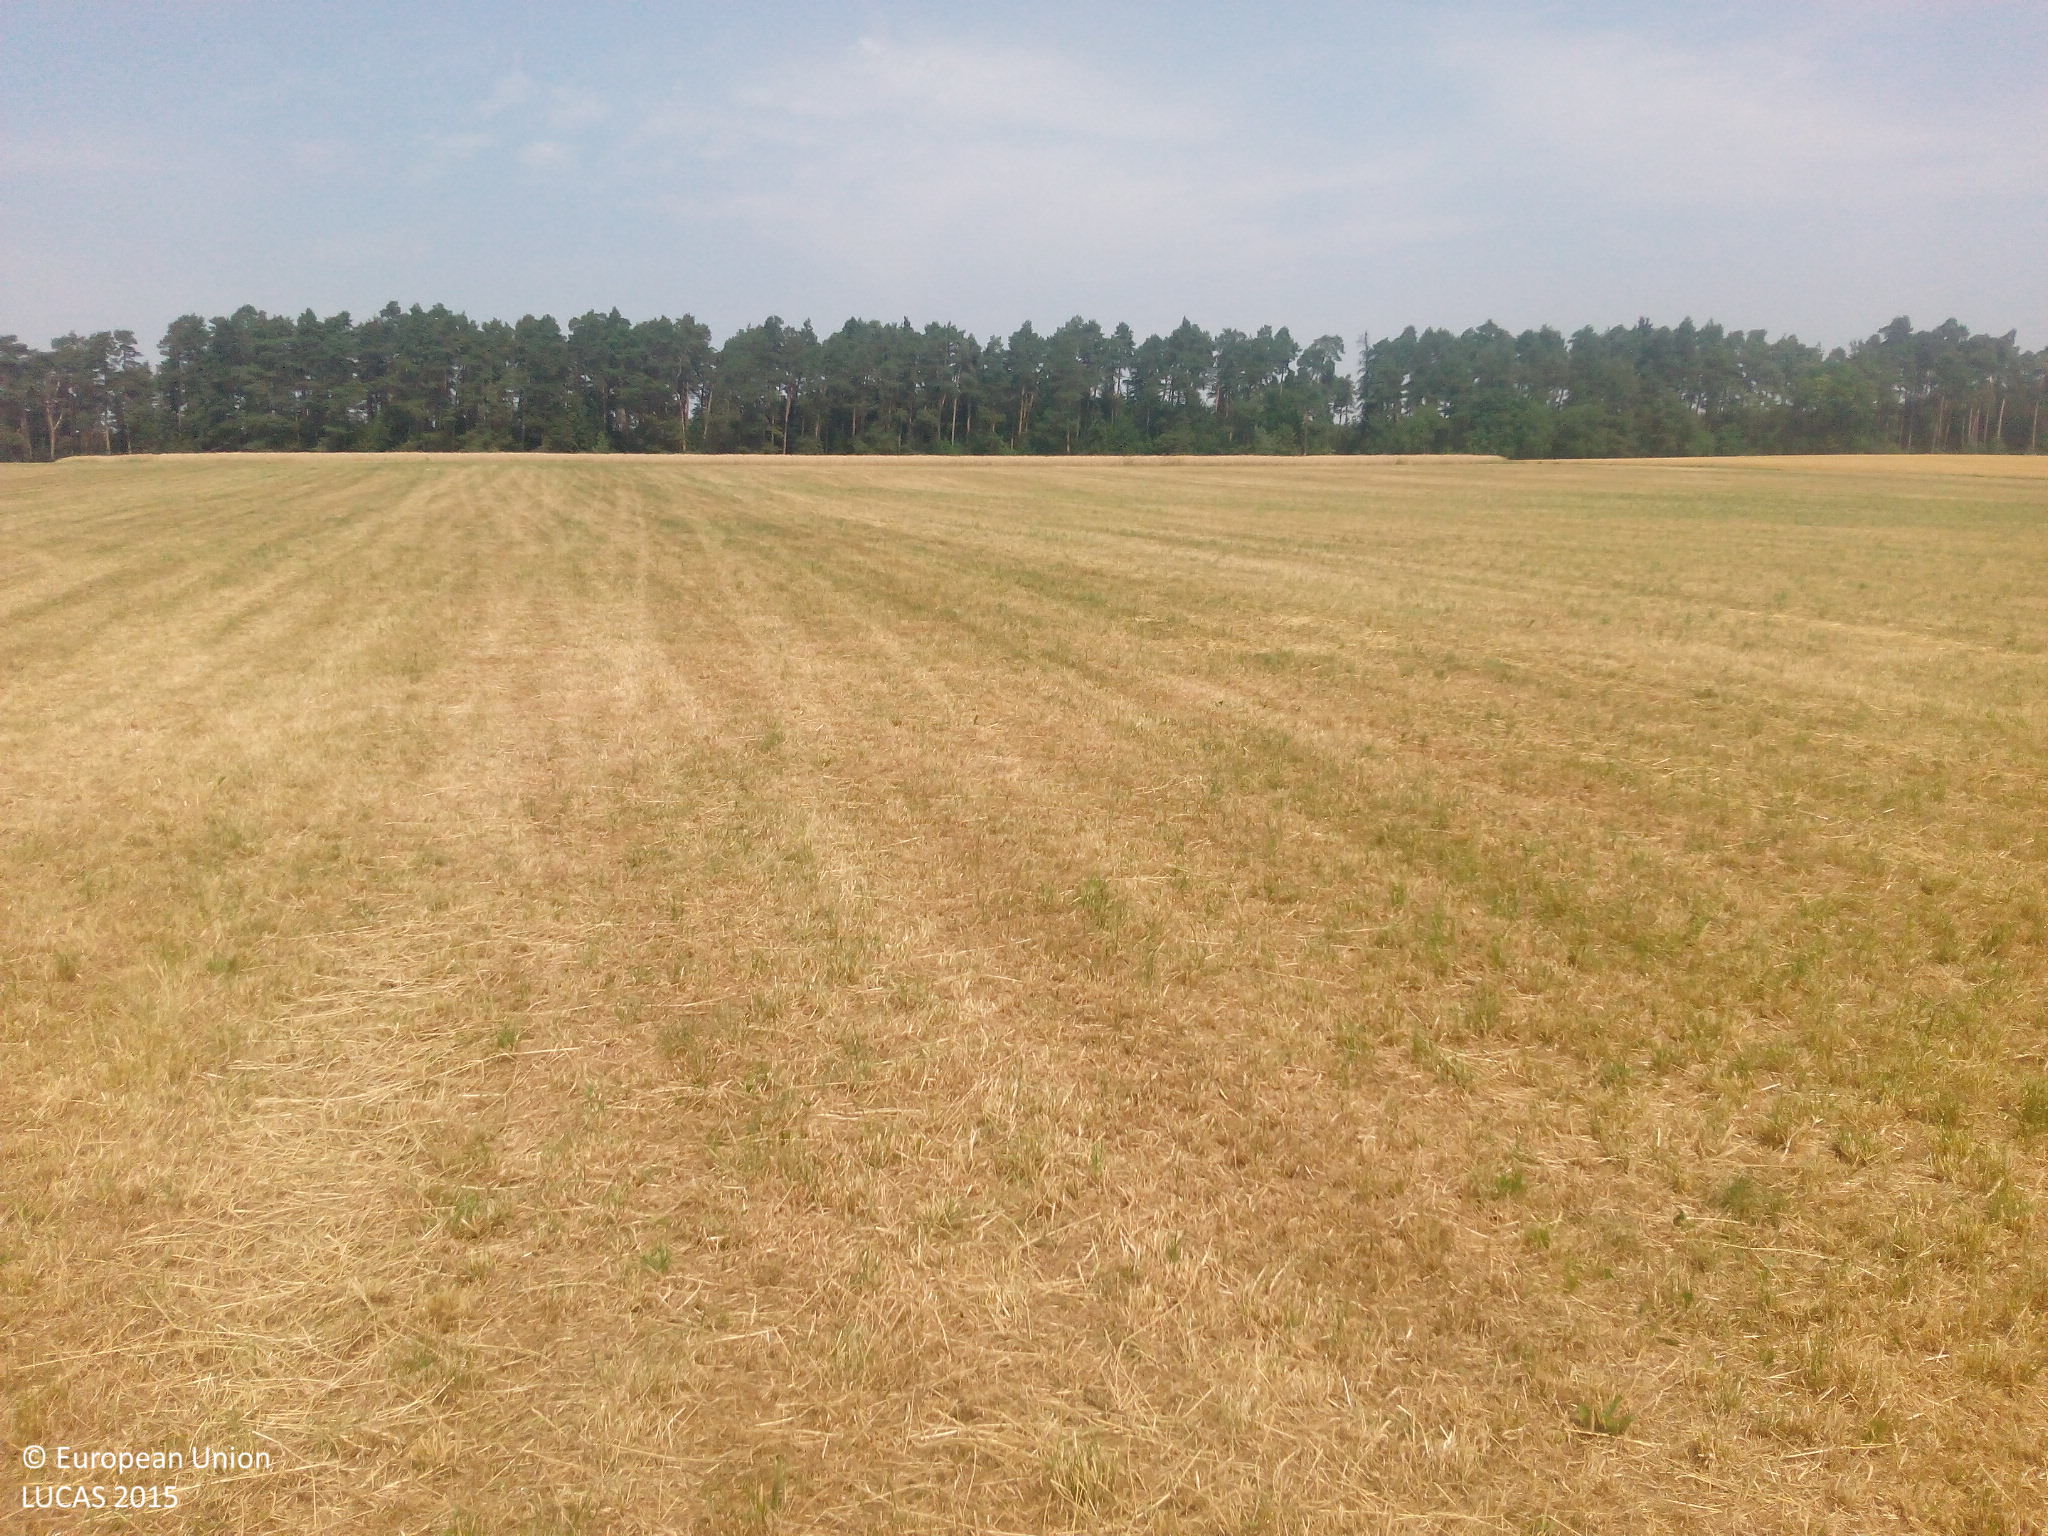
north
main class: Grassland
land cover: Grassland without tree/shrub cover
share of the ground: > 75 %
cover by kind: herbaceous plants 100 %
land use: Agriculture (excluding fallow land and kitchen gardens)
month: July
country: DE
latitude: 49.4092
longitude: 10.6200
